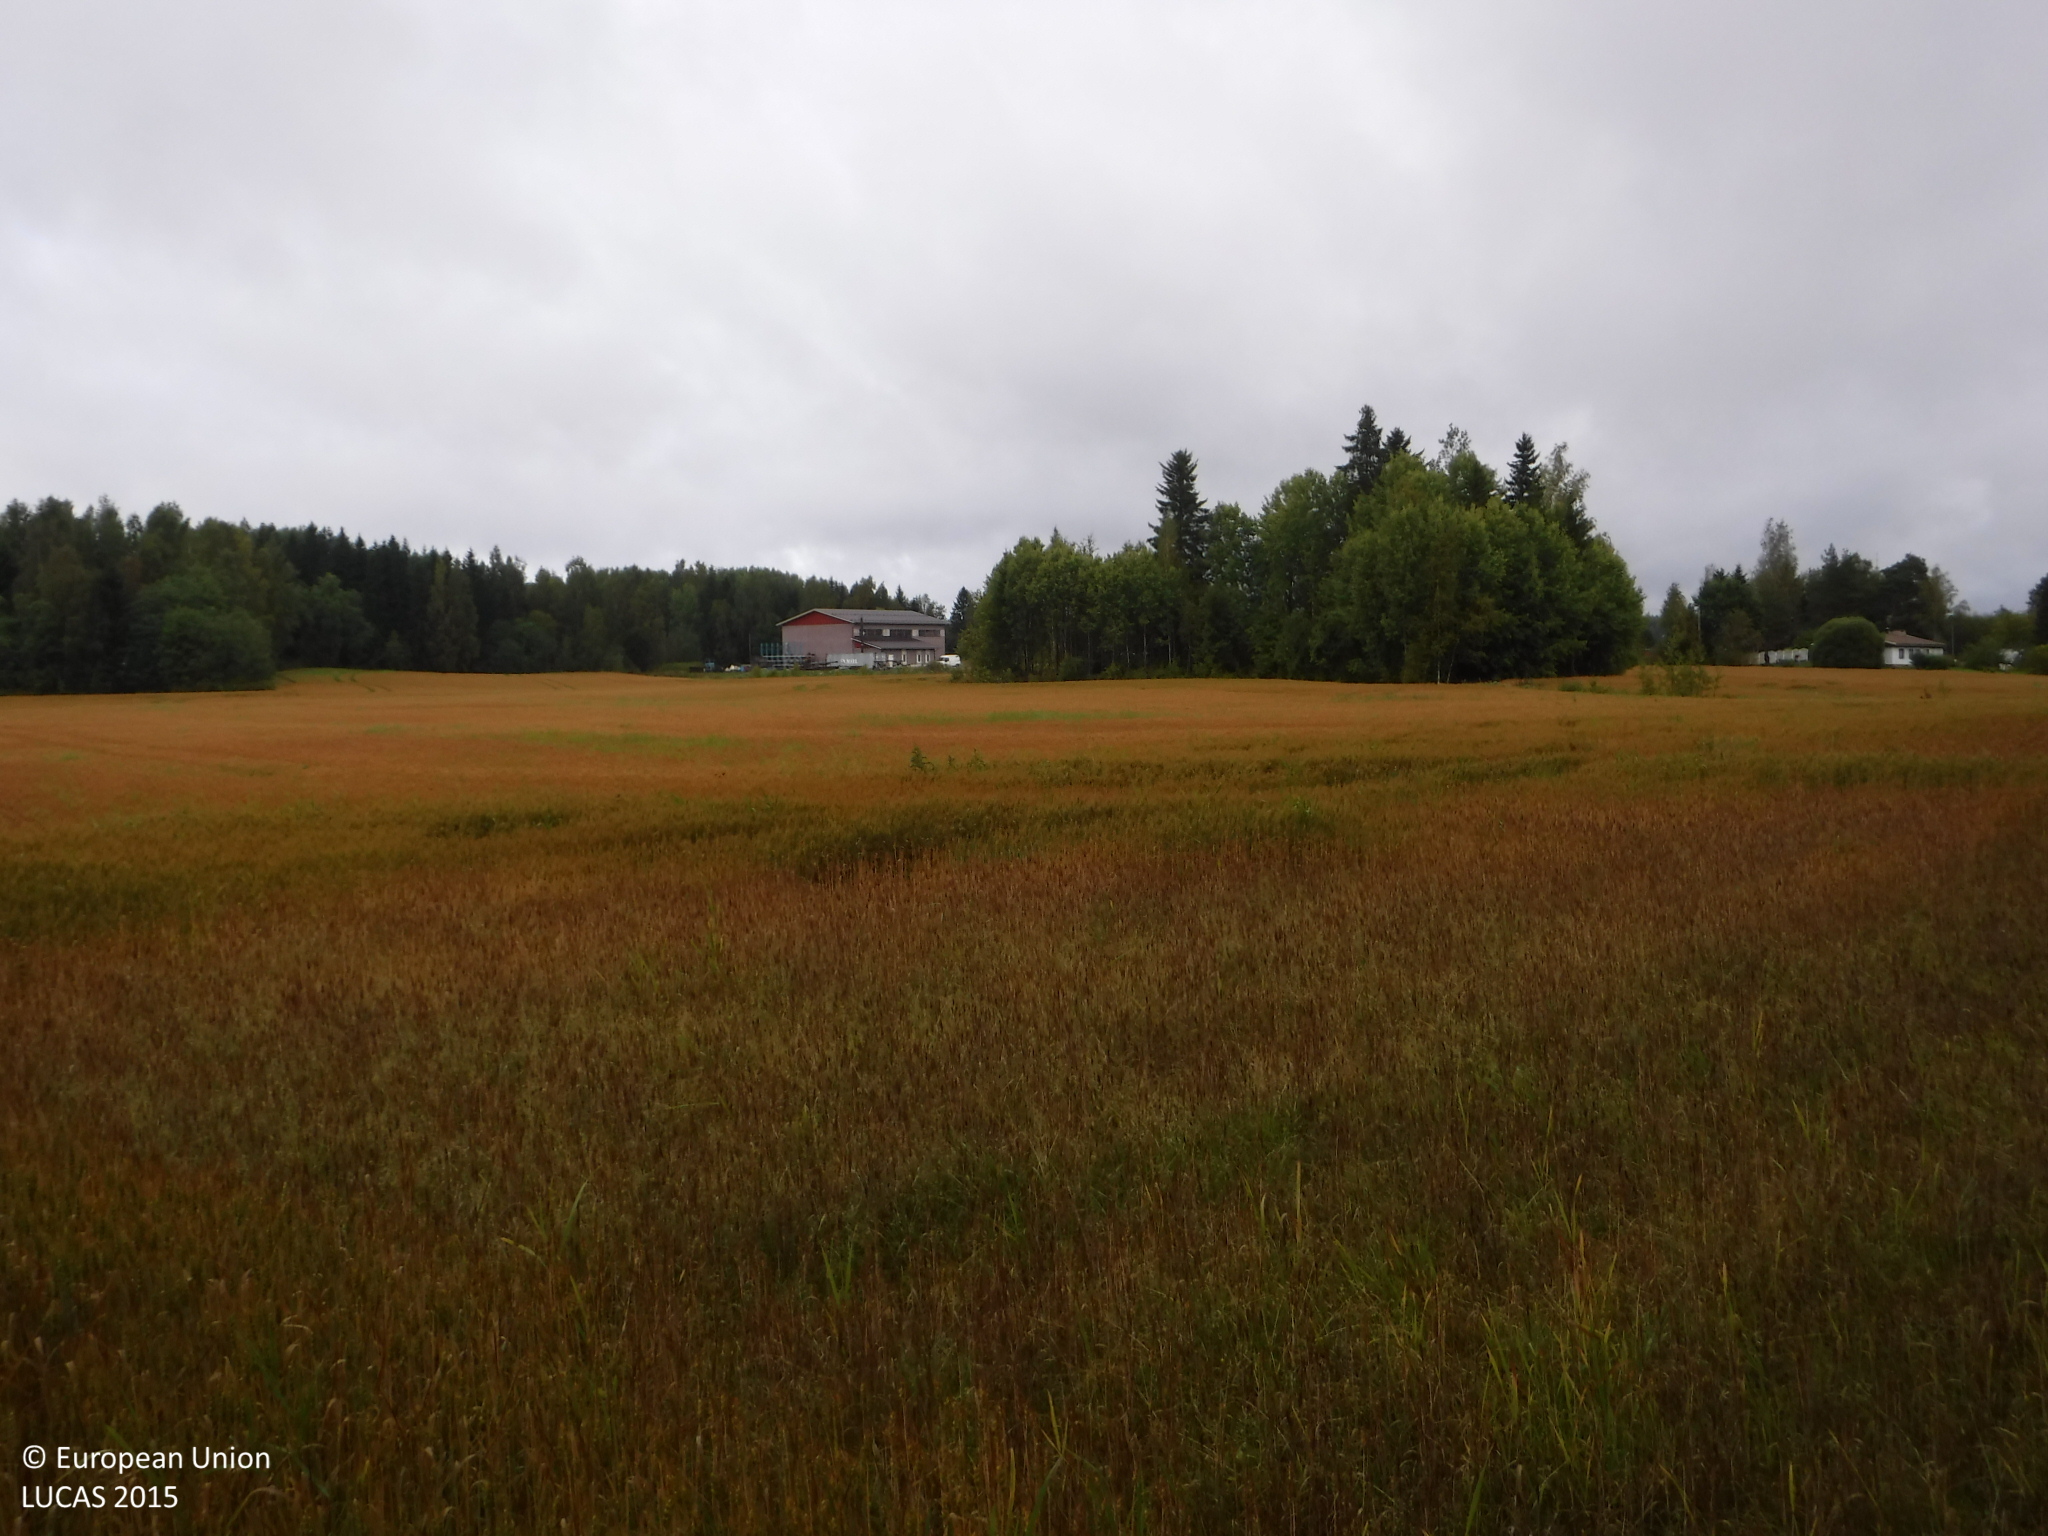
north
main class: Cropland
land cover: Common wheat
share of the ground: > 75 %
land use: Agriculture (excluding fallow land and kitchen gardens)
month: September
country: FI
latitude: 61.3298
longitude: 23.0212
